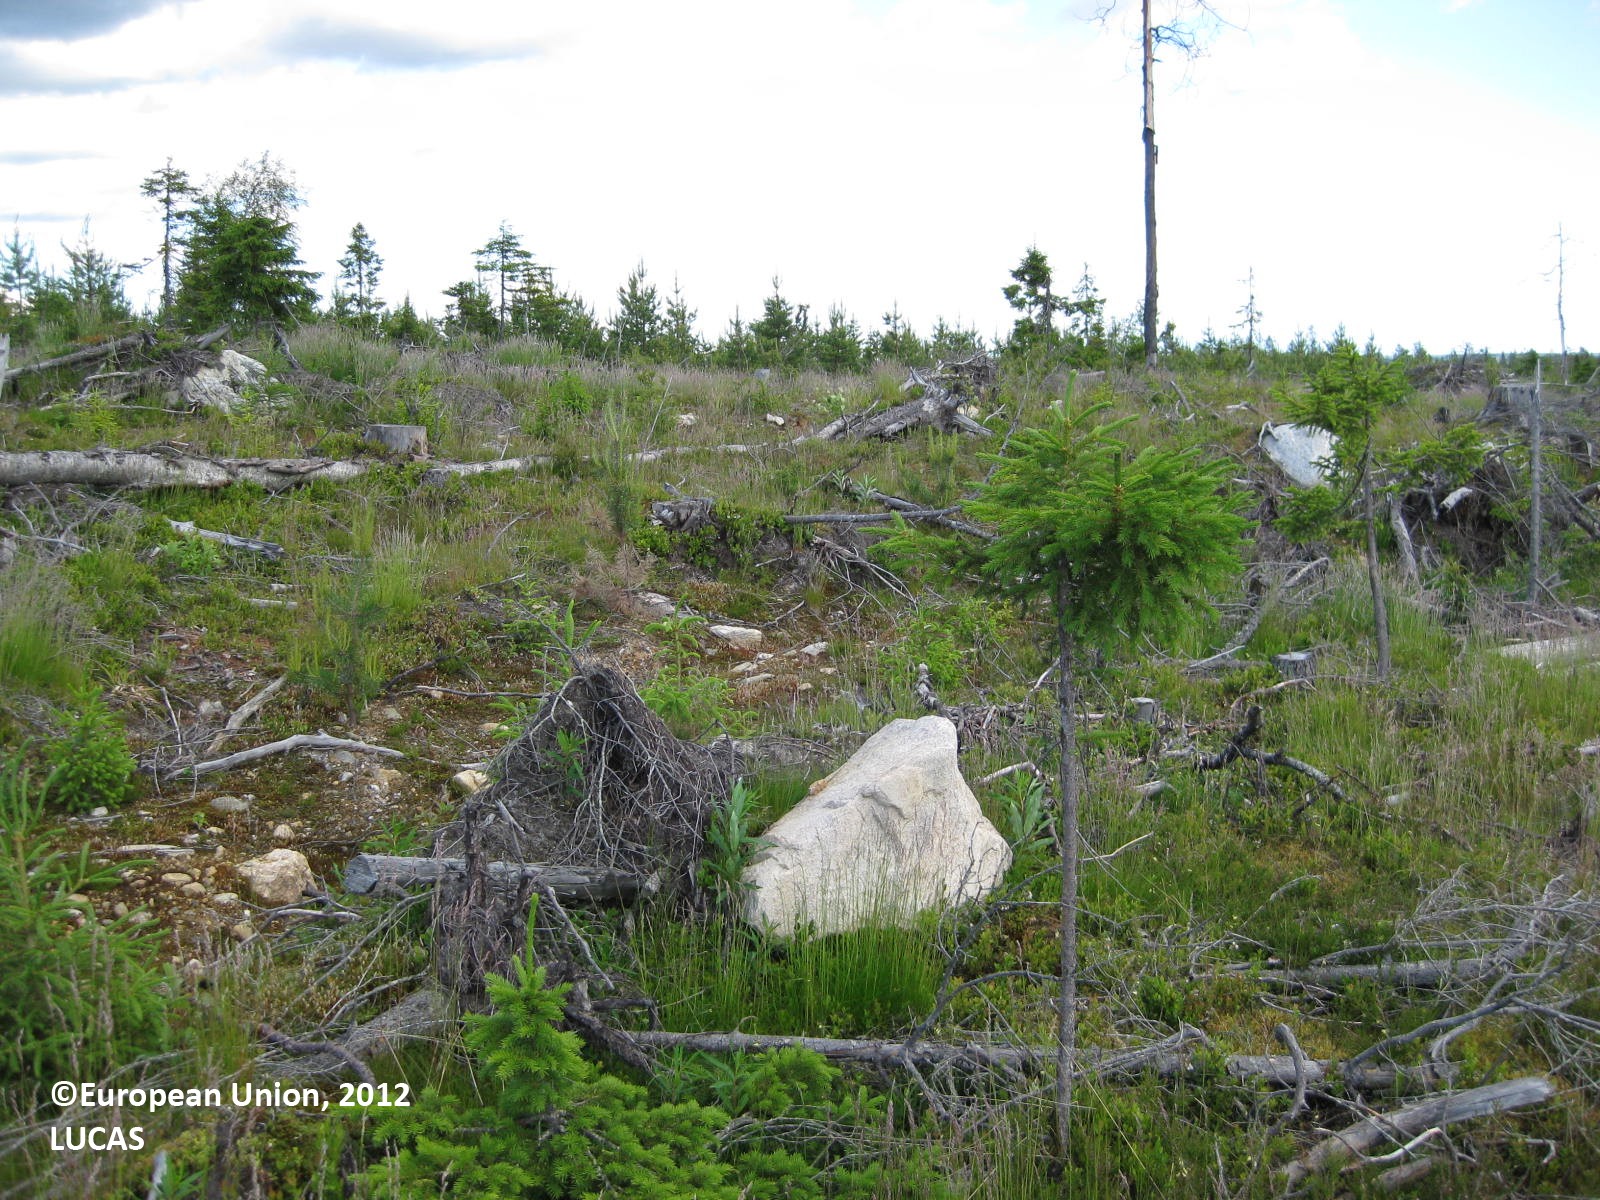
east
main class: Grassland
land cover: Grassland with sparse tree/shrub cover
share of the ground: > 75 %
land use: Forestry
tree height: < 5 m
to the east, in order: Grassland with sparse tree/shrub cover; Ditches and canals; Grassland with sparse tree/shrub cover; Ditches and canals; Grassland with sparse tree/shrub cover; Ditches and canals; Grassland with sparse tree/shrub cover; Ditches and canals; Other coniferous woodland; Ditches and canals; Pine dominated coniferous woodland; Ditches and canals; Pine dominated coniferous woodland; Ditches and canals; Pine dominated coniferous woodland; Ditches and canals; Pine dominated coniferous woodland; Ditches and canals; Pine dominated coniferous woodland; Ditches and canals; Pine dominated coniferous woodland; Ditches and canals; Pine dominated coniferous woodland; Ditches and canals; Pine dominated coniferous woodland; Ditches and canals; Pine dominated coniferous woodland; Ditches and canals; Pine dominated coniferous woodland; Ditches and canals; Pine dominated coniferous woodland; Ditches and canals; Pine dominated coniferous woodland; Ditches and canals; Pine dominated coniferous woodland; Ditches and canals; Pine dominated coniferous woodland; Ditches and canals; Pine dominated coniferous woodland; Ditches and canals; Pine dominated coniferous woodland; Ditches and canals; Pine dominated coniferous woodland
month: July
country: FI
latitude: 65.5740
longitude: 29.4627
